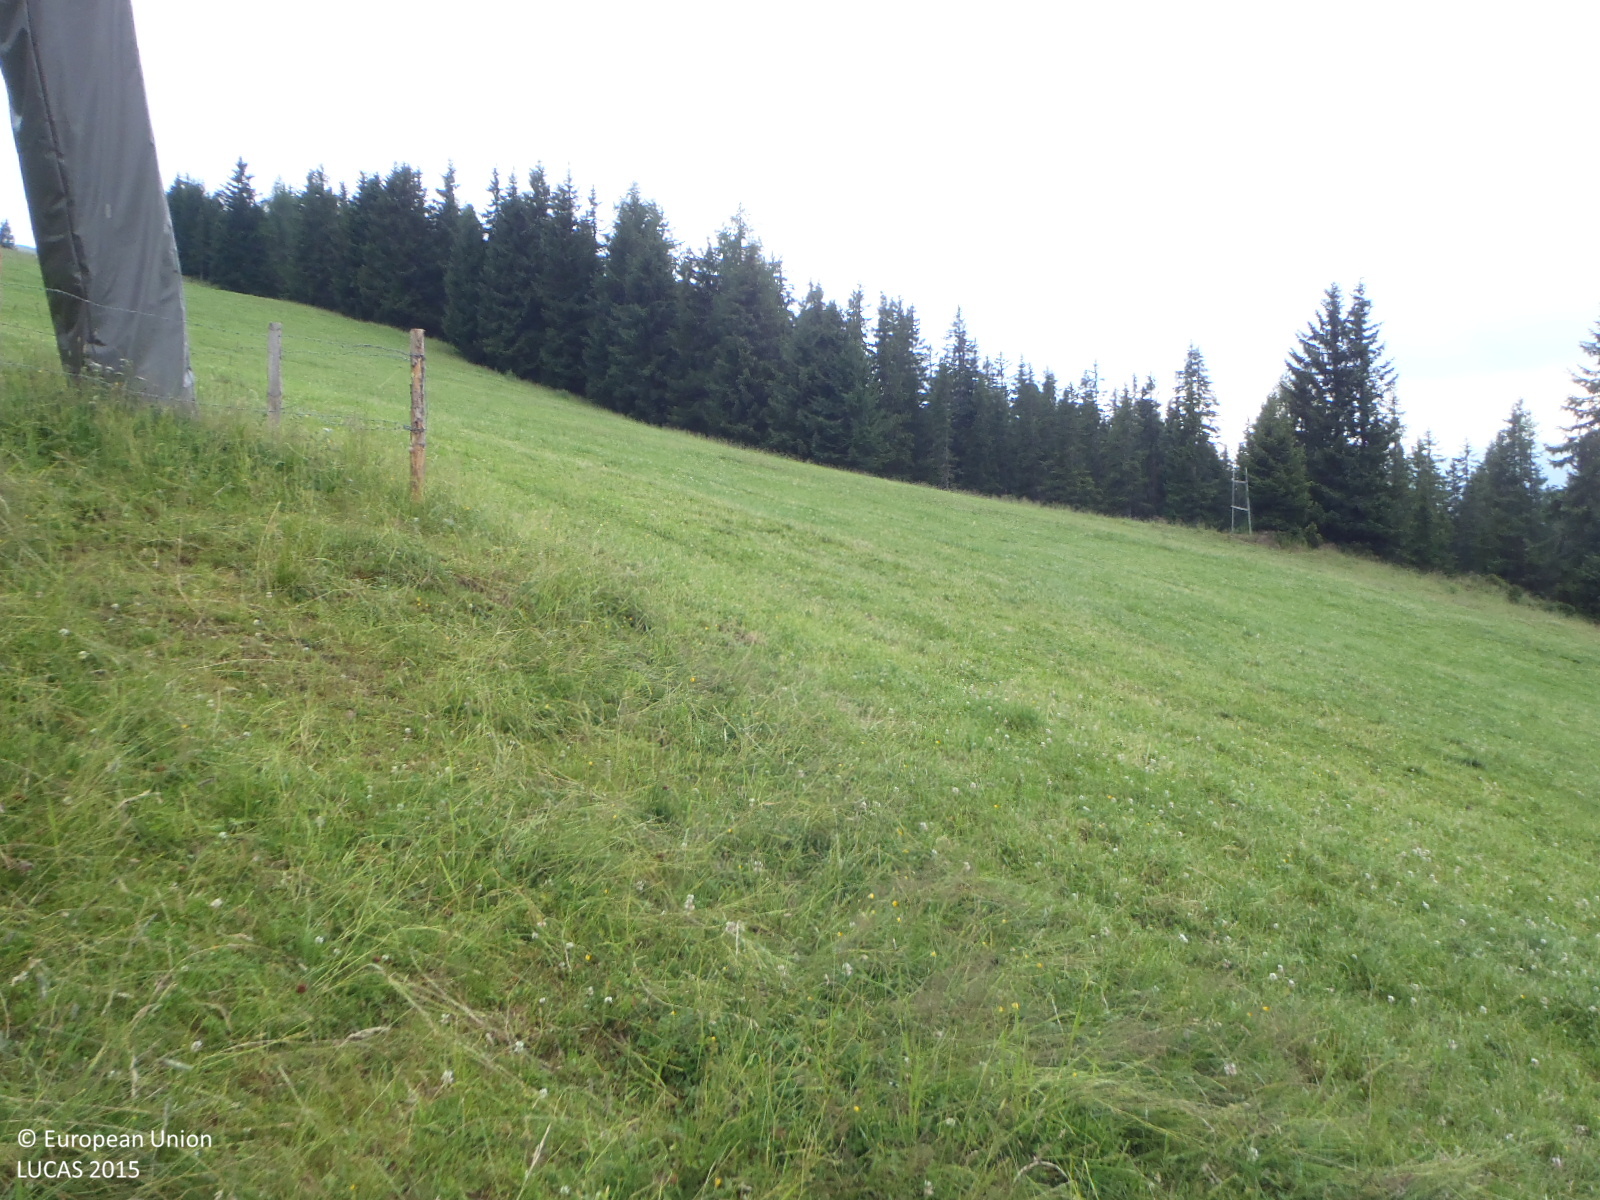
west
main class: Grassland
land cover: Grassland without tree/shrub cover
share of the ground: > 75 %
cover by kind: herbaceous plants 100 %
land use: Agriculture (excluding fallow land and kitchen gardens)
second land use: Sport
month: July
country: AT
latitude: 47.2303
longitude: 12.1511
